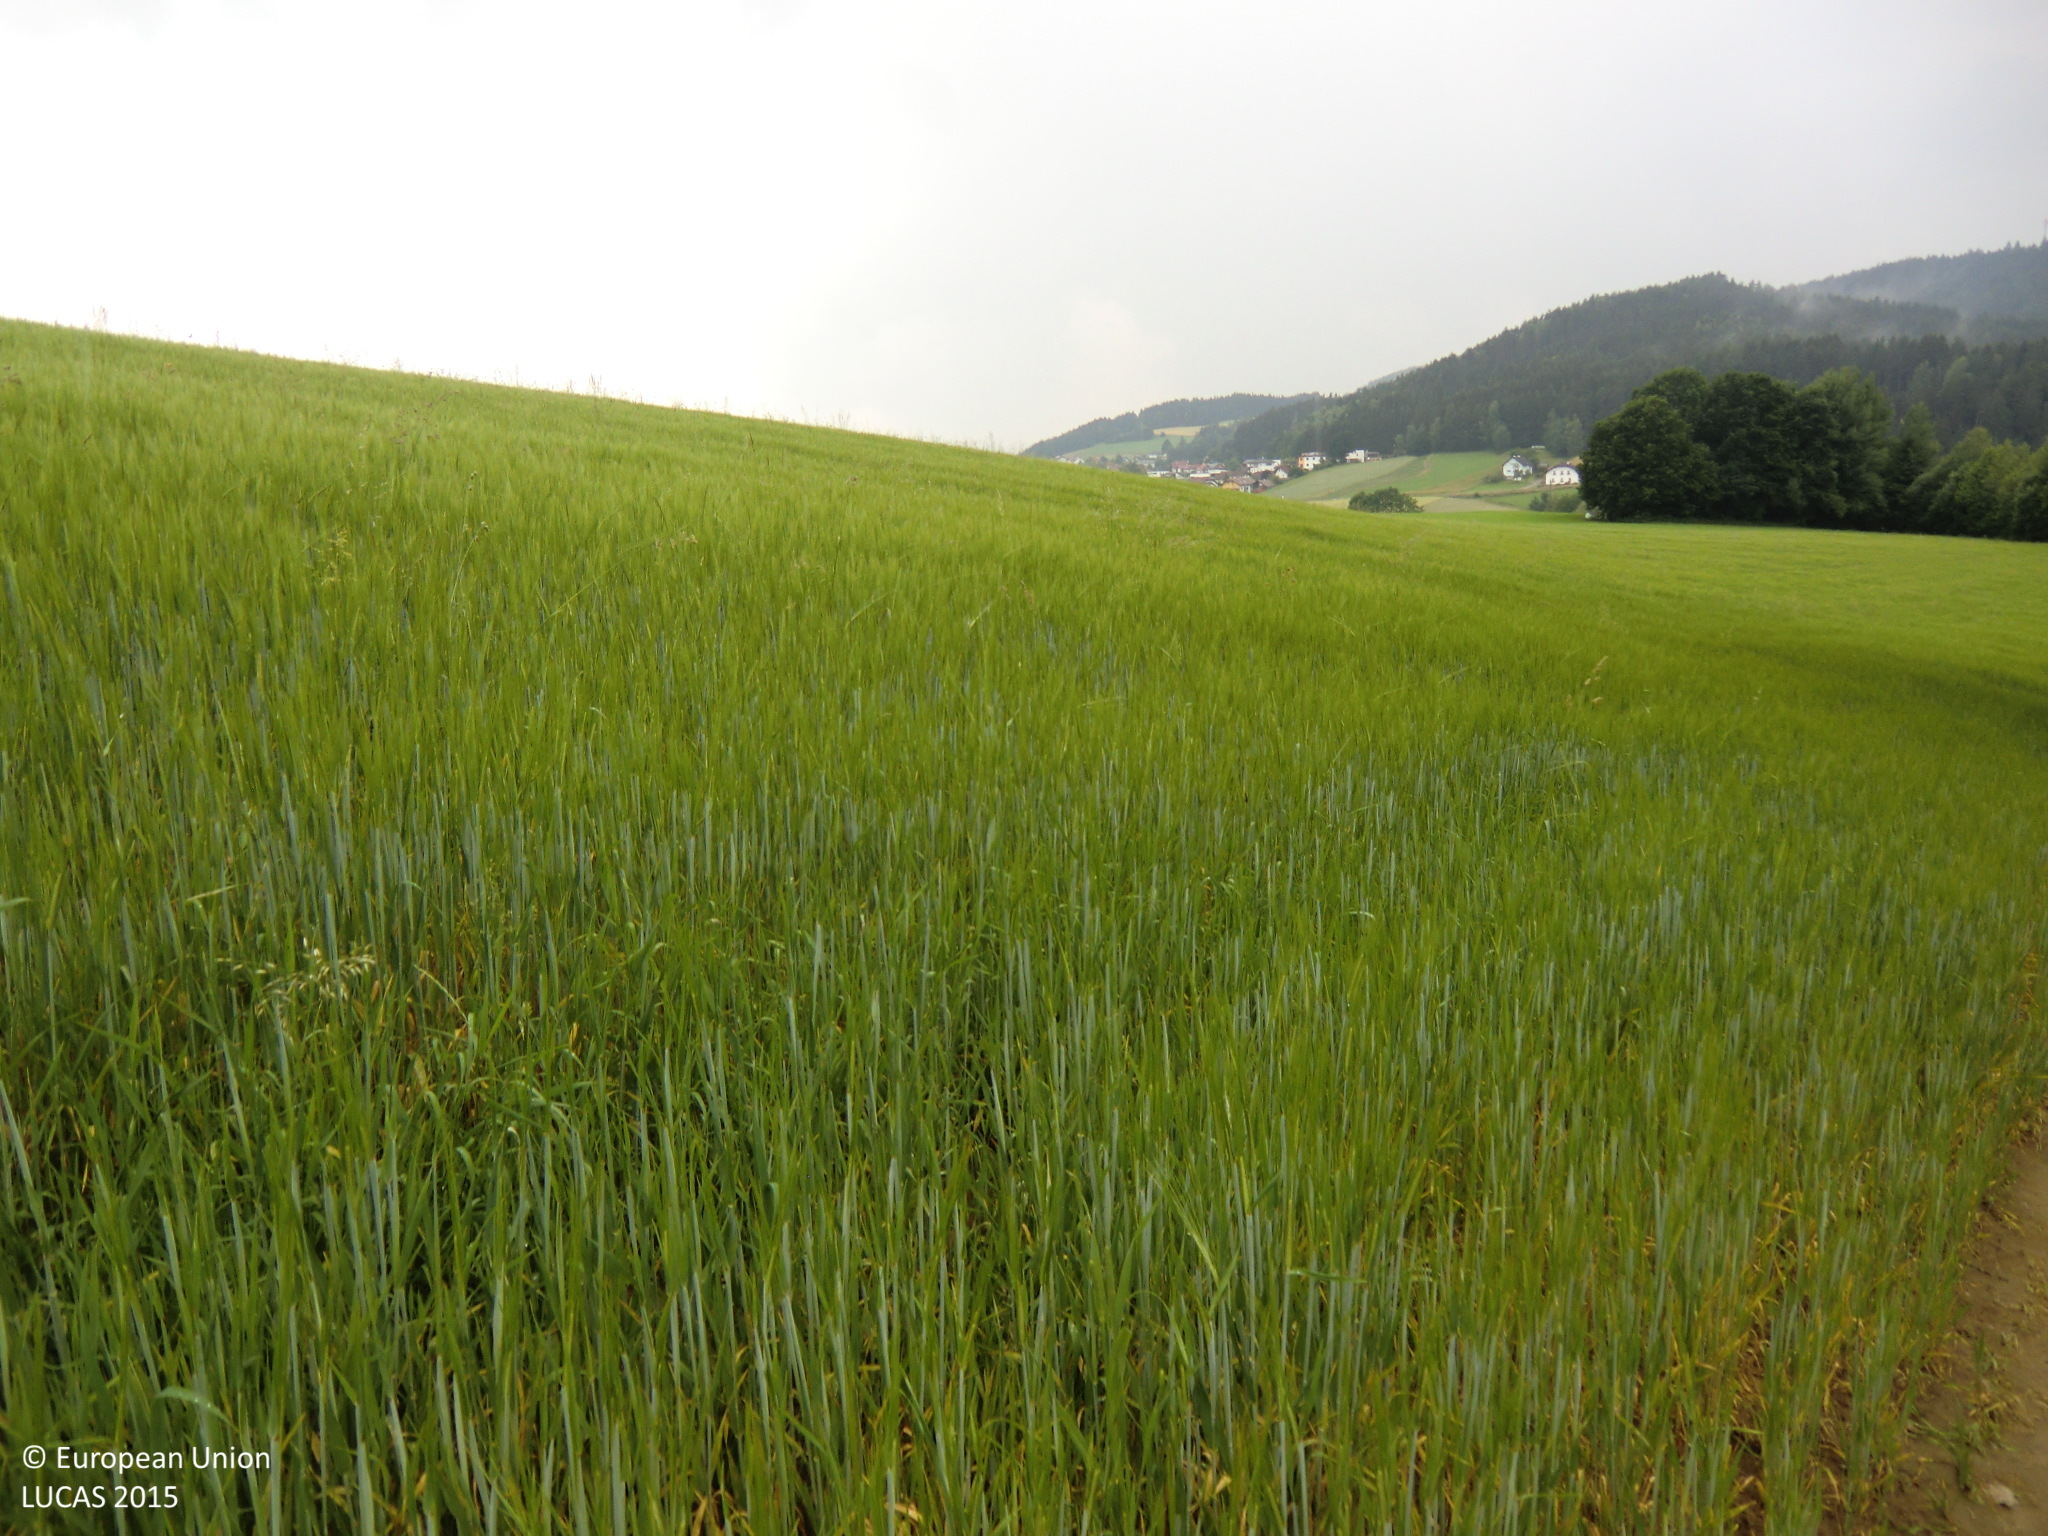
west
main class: Cropland
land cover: Rye
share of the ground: > 75 %
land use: Agriculture (excluding fallow land and kitchen gardens)
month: June
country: AT
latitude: 48.4717
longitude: 14.5591
